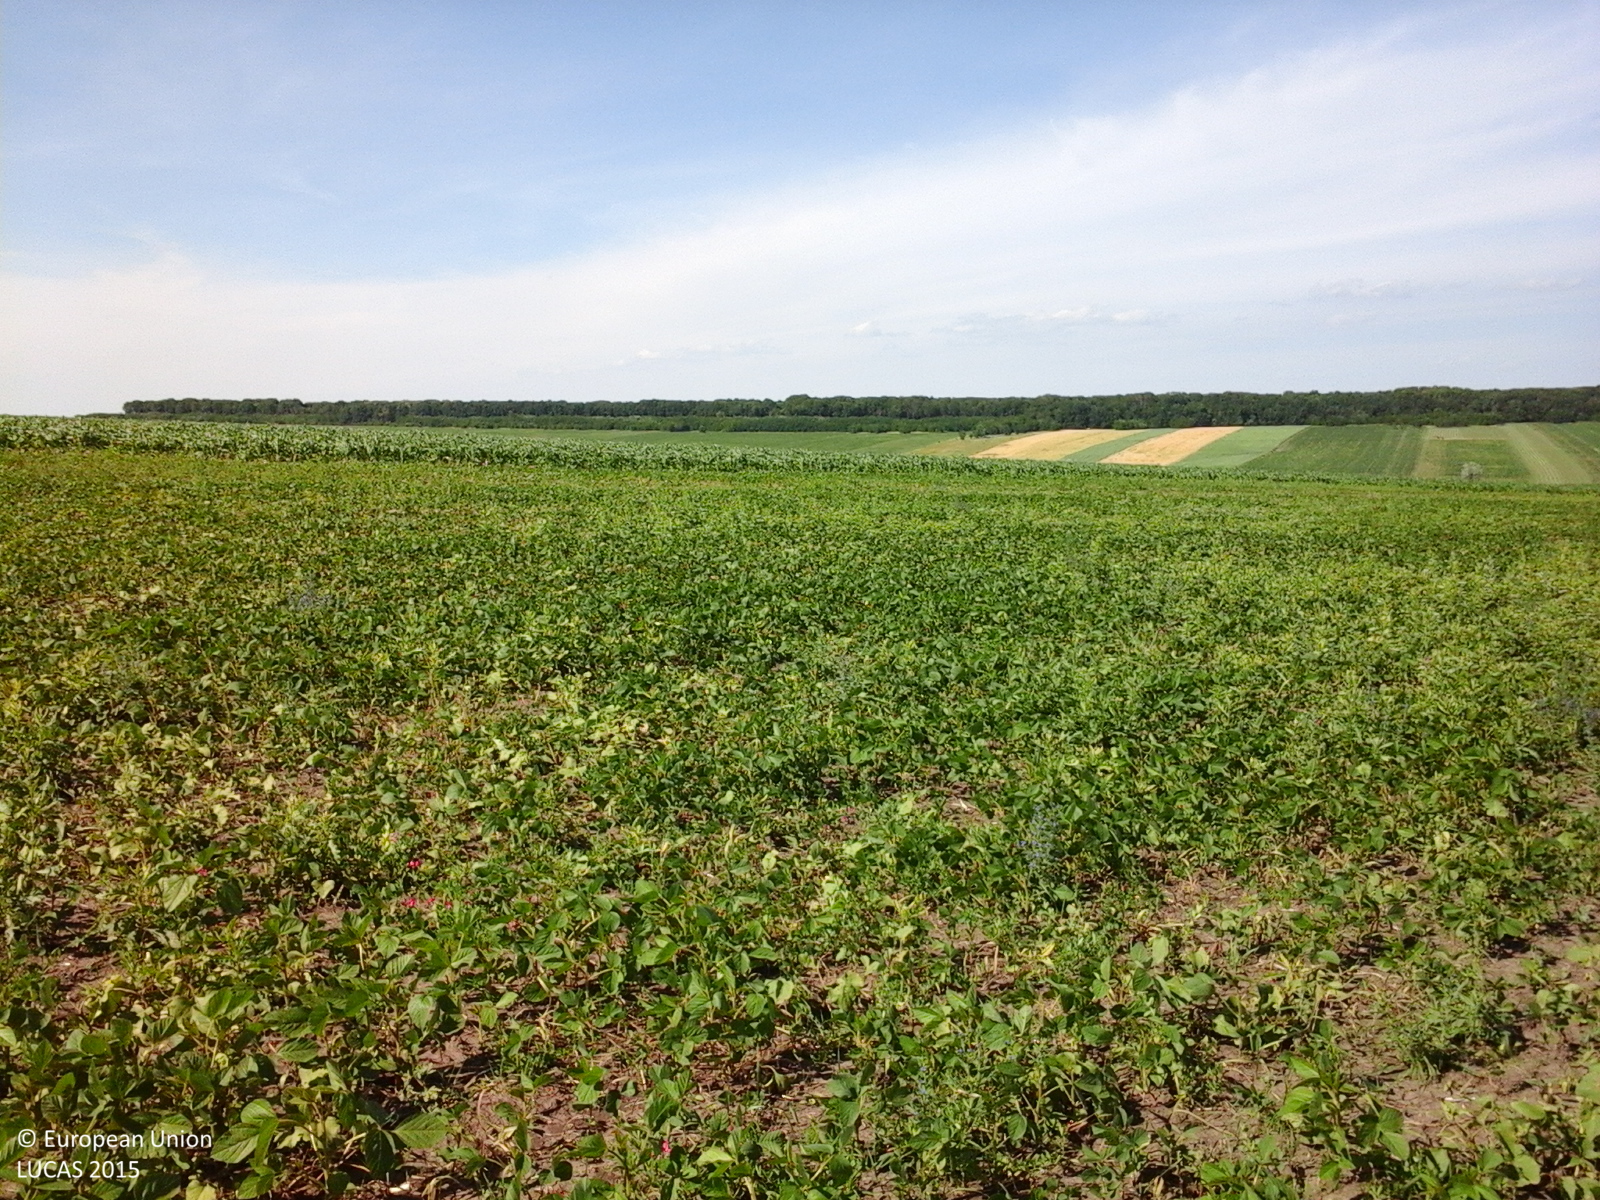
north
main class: Cropland
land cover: Soya
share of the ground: > 75 %
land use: Agriculture (excluding fallow land and kitchen gardens)
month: June
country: RO
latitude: 48.0747
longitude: 26.9499
